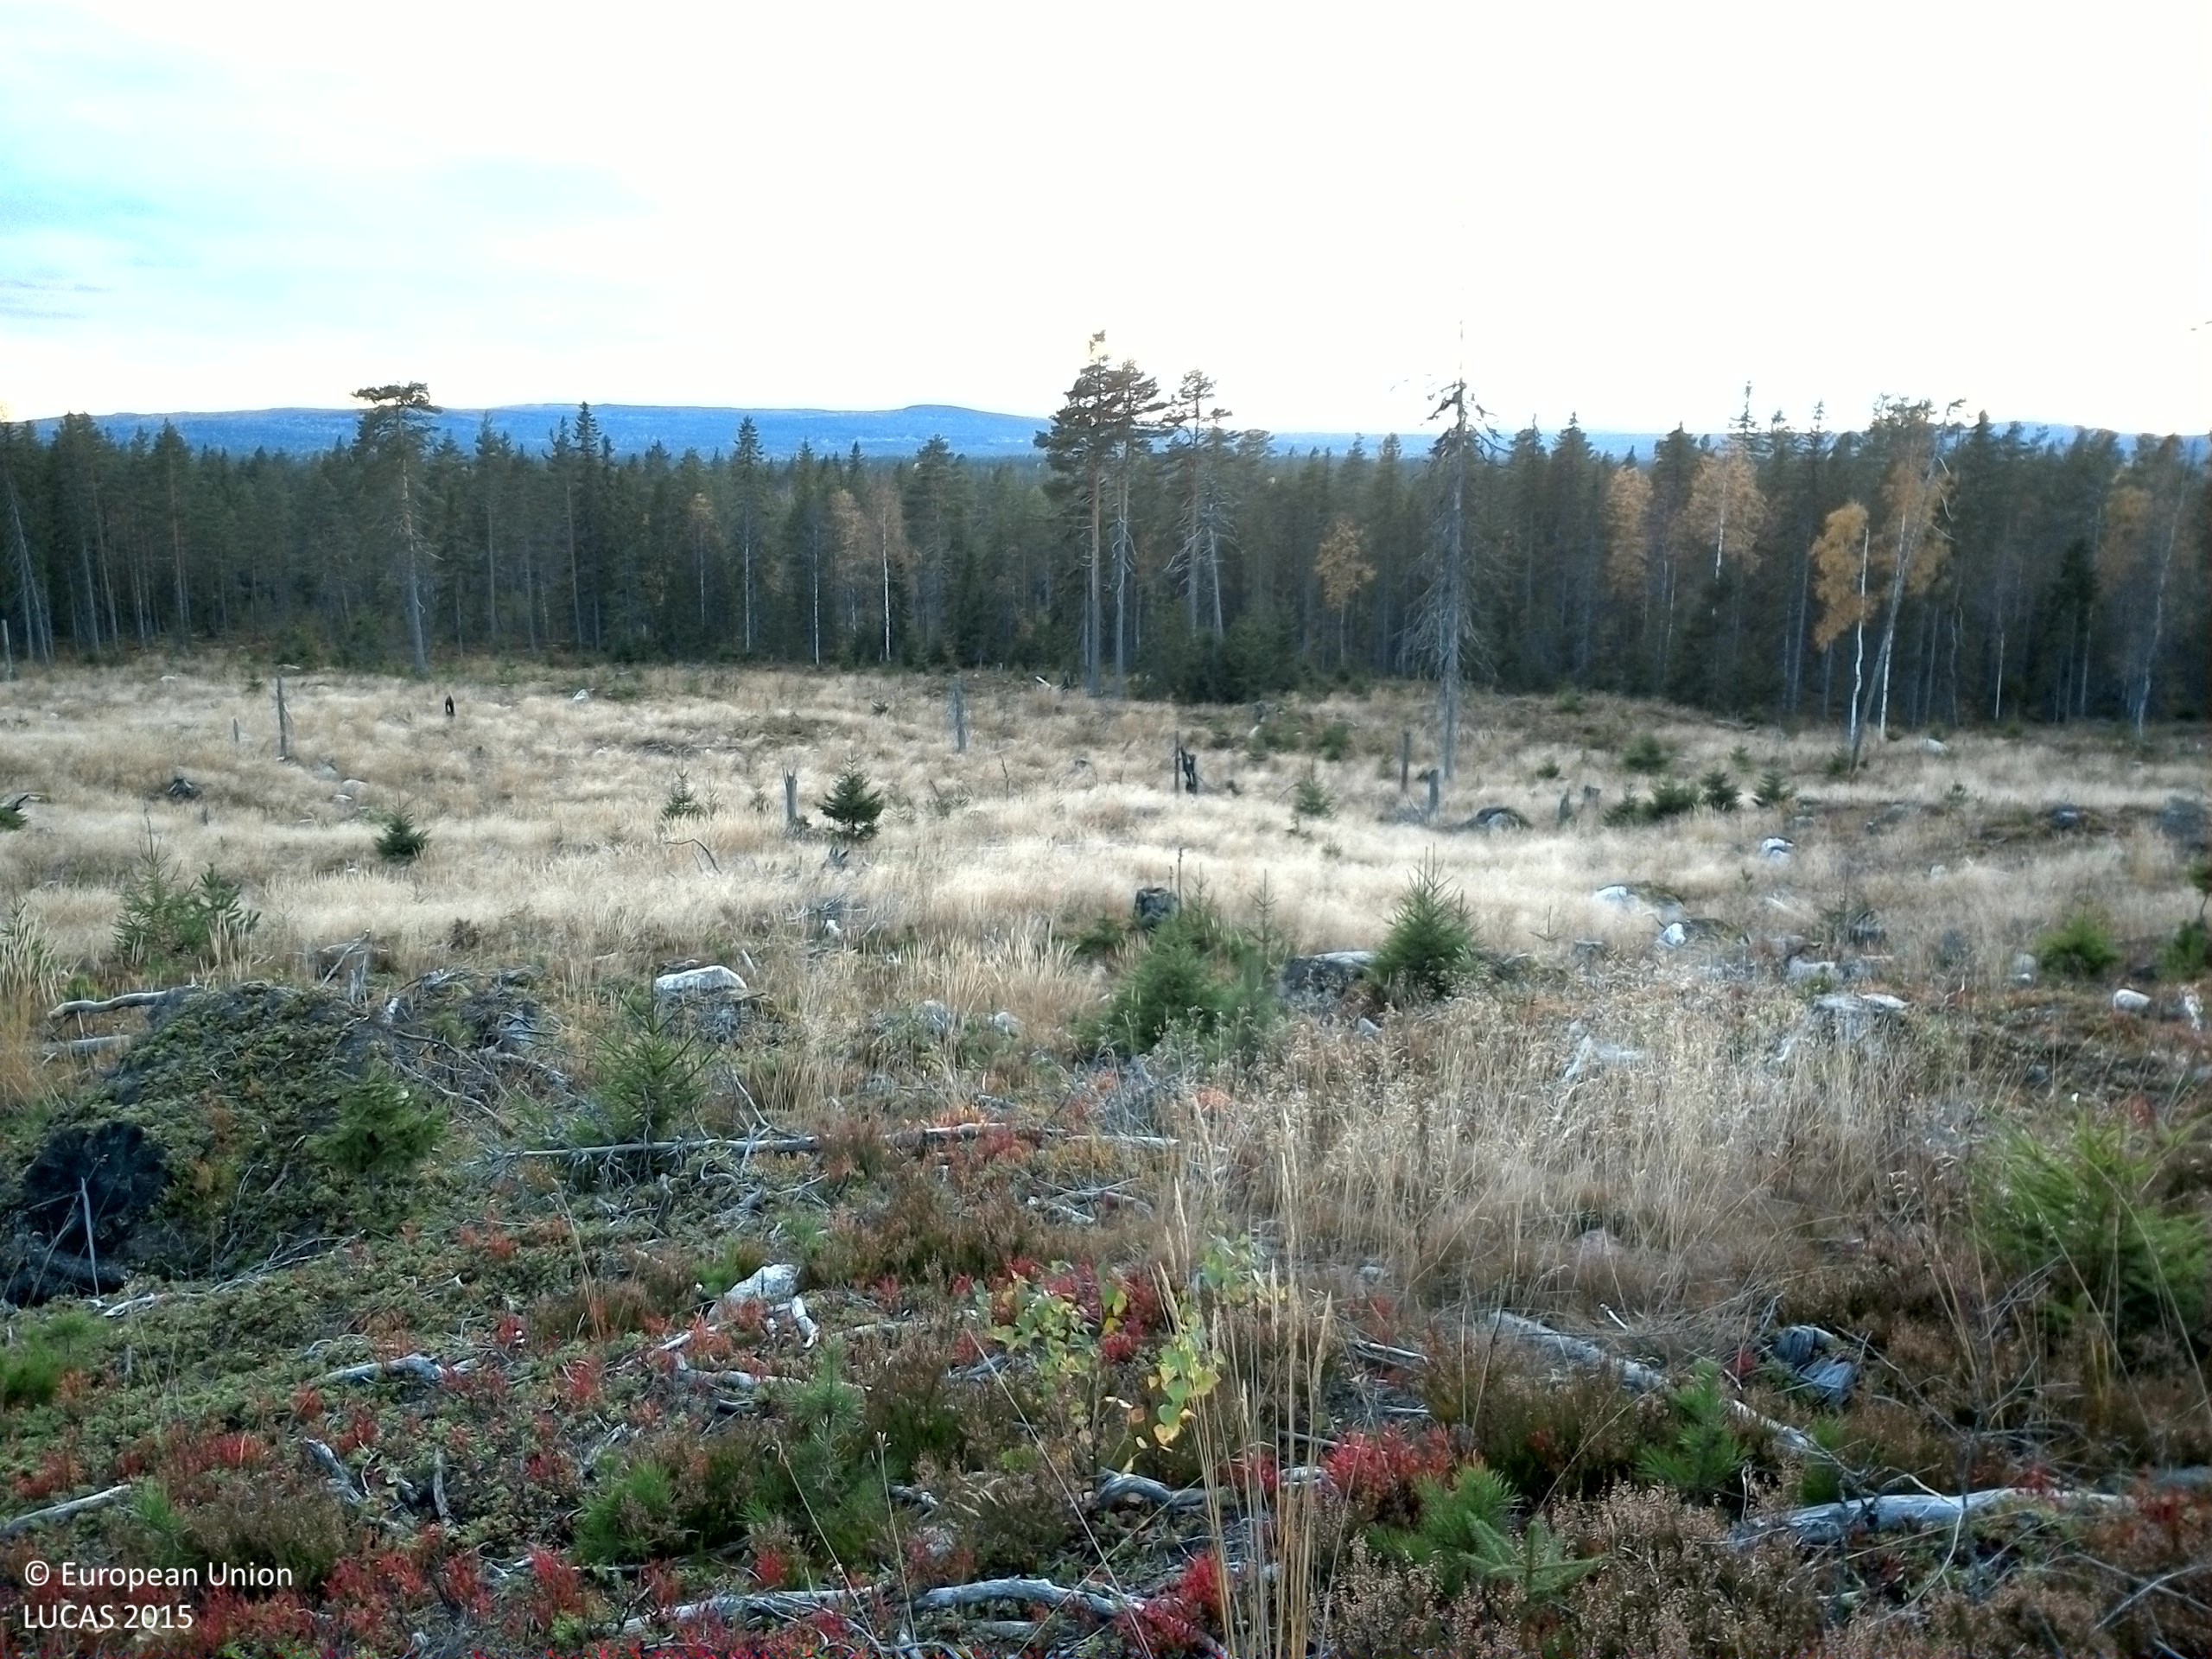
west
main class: Shrubland
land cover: Shrubland with sparse tree cover
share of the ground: > 75 %
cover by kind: shrubs 50 %, herbaceous plants 15 %, lichens and mosses 15 %, consolidated bare surface 15 %, coniferous forest trees 5 %
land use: Forestry
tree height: < 5 m
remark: Clear cut
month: October
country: SE
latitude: 61.4074
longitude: 15.0608
